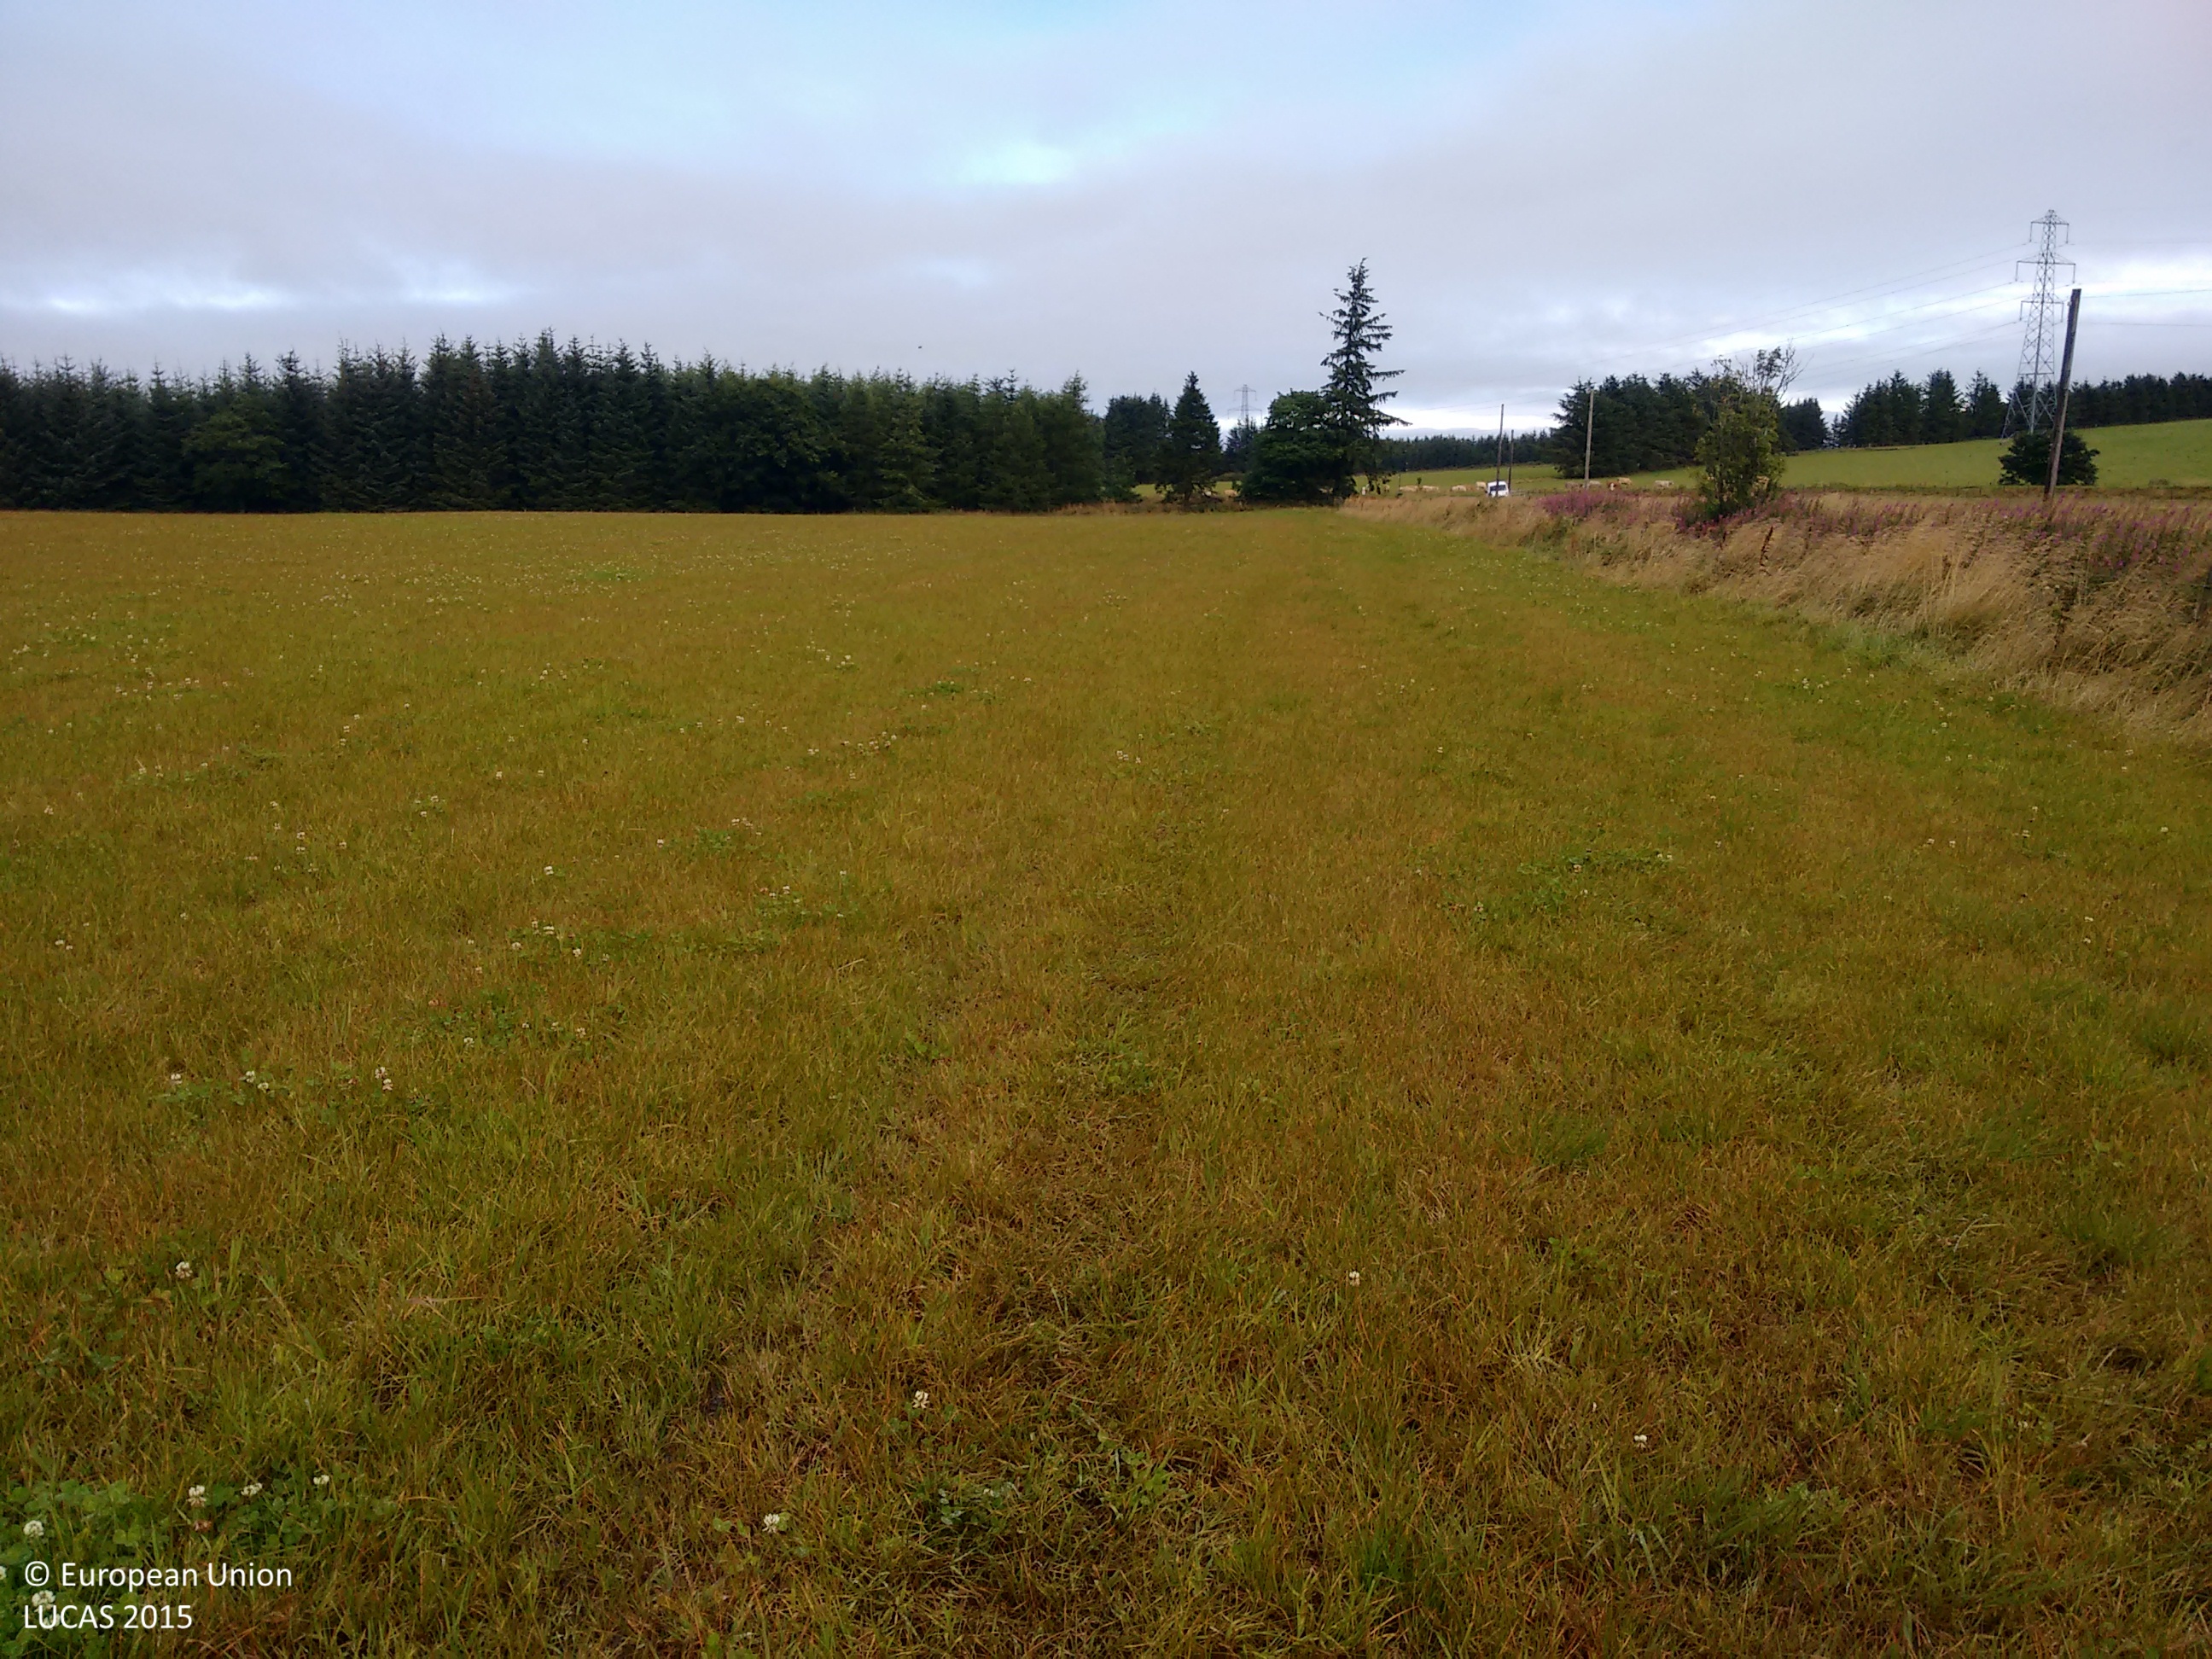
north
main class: Grassland
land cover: Grassland without tree/shrub cover
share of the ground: > 75 %
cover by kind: herbaceous plants 95 %, unconsolidated bare surface 5 %
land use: Agriculture (excluding fallow land and kitchen gardens)
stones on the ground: 10 - 25 %
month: September
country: GB
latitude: 57.5006
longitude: -2.9259
